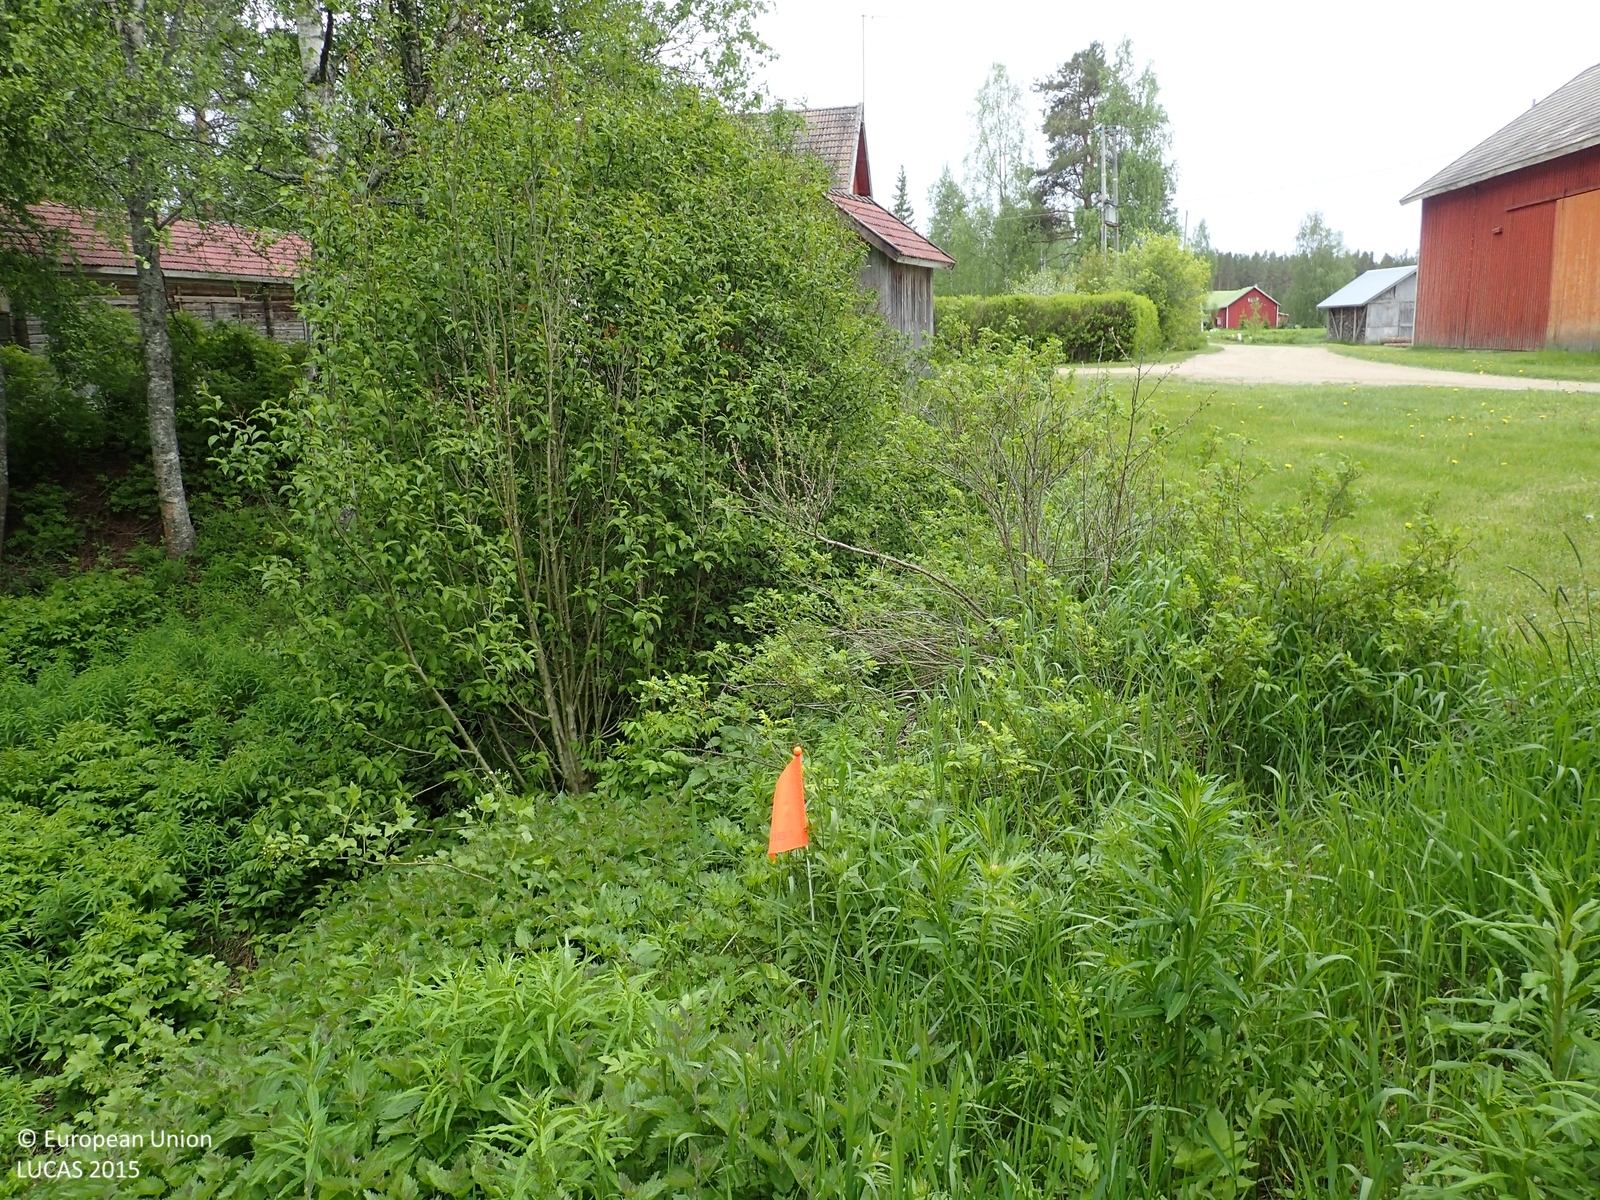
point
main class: Grassland
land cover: Grassland with sparse tree/shrub cover
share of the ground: > 75 %
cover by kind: herbaceous plants 95 %, broadleaved forest trees 5 %
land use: Residential
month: June
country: FI
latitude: 62.4212
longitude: 22.4666
